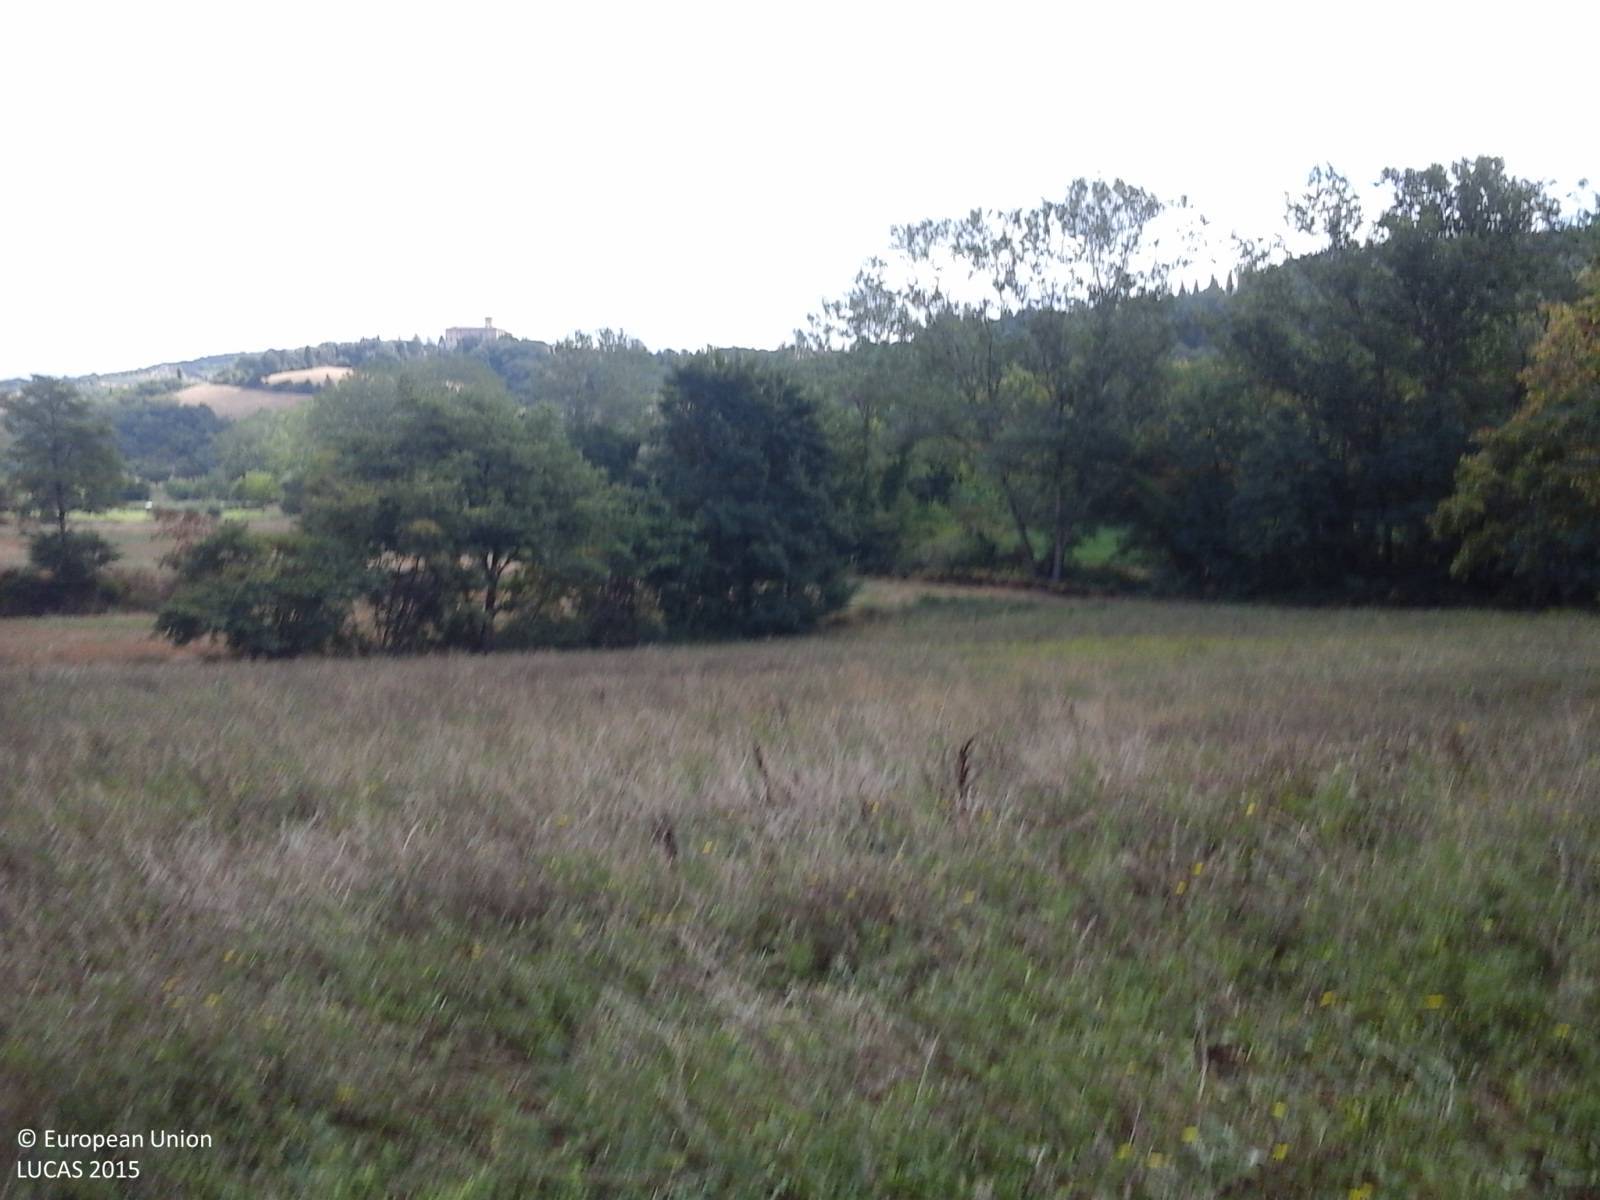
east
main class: Cropland
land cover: Temporary grasslands
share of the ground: > 75 %
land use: Agriculture (excluding fallow land and kitchen gardens)
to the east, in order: Temporary grasslands; Abandoned hedges; Spontaneously vegetated surfaces; Abandoned hedges; Common wheat; Abandoned hedges; Rivers and streams; Abandoned hedges; Tracks
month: August
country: IT
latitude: 43.4629
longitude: 12.1078
